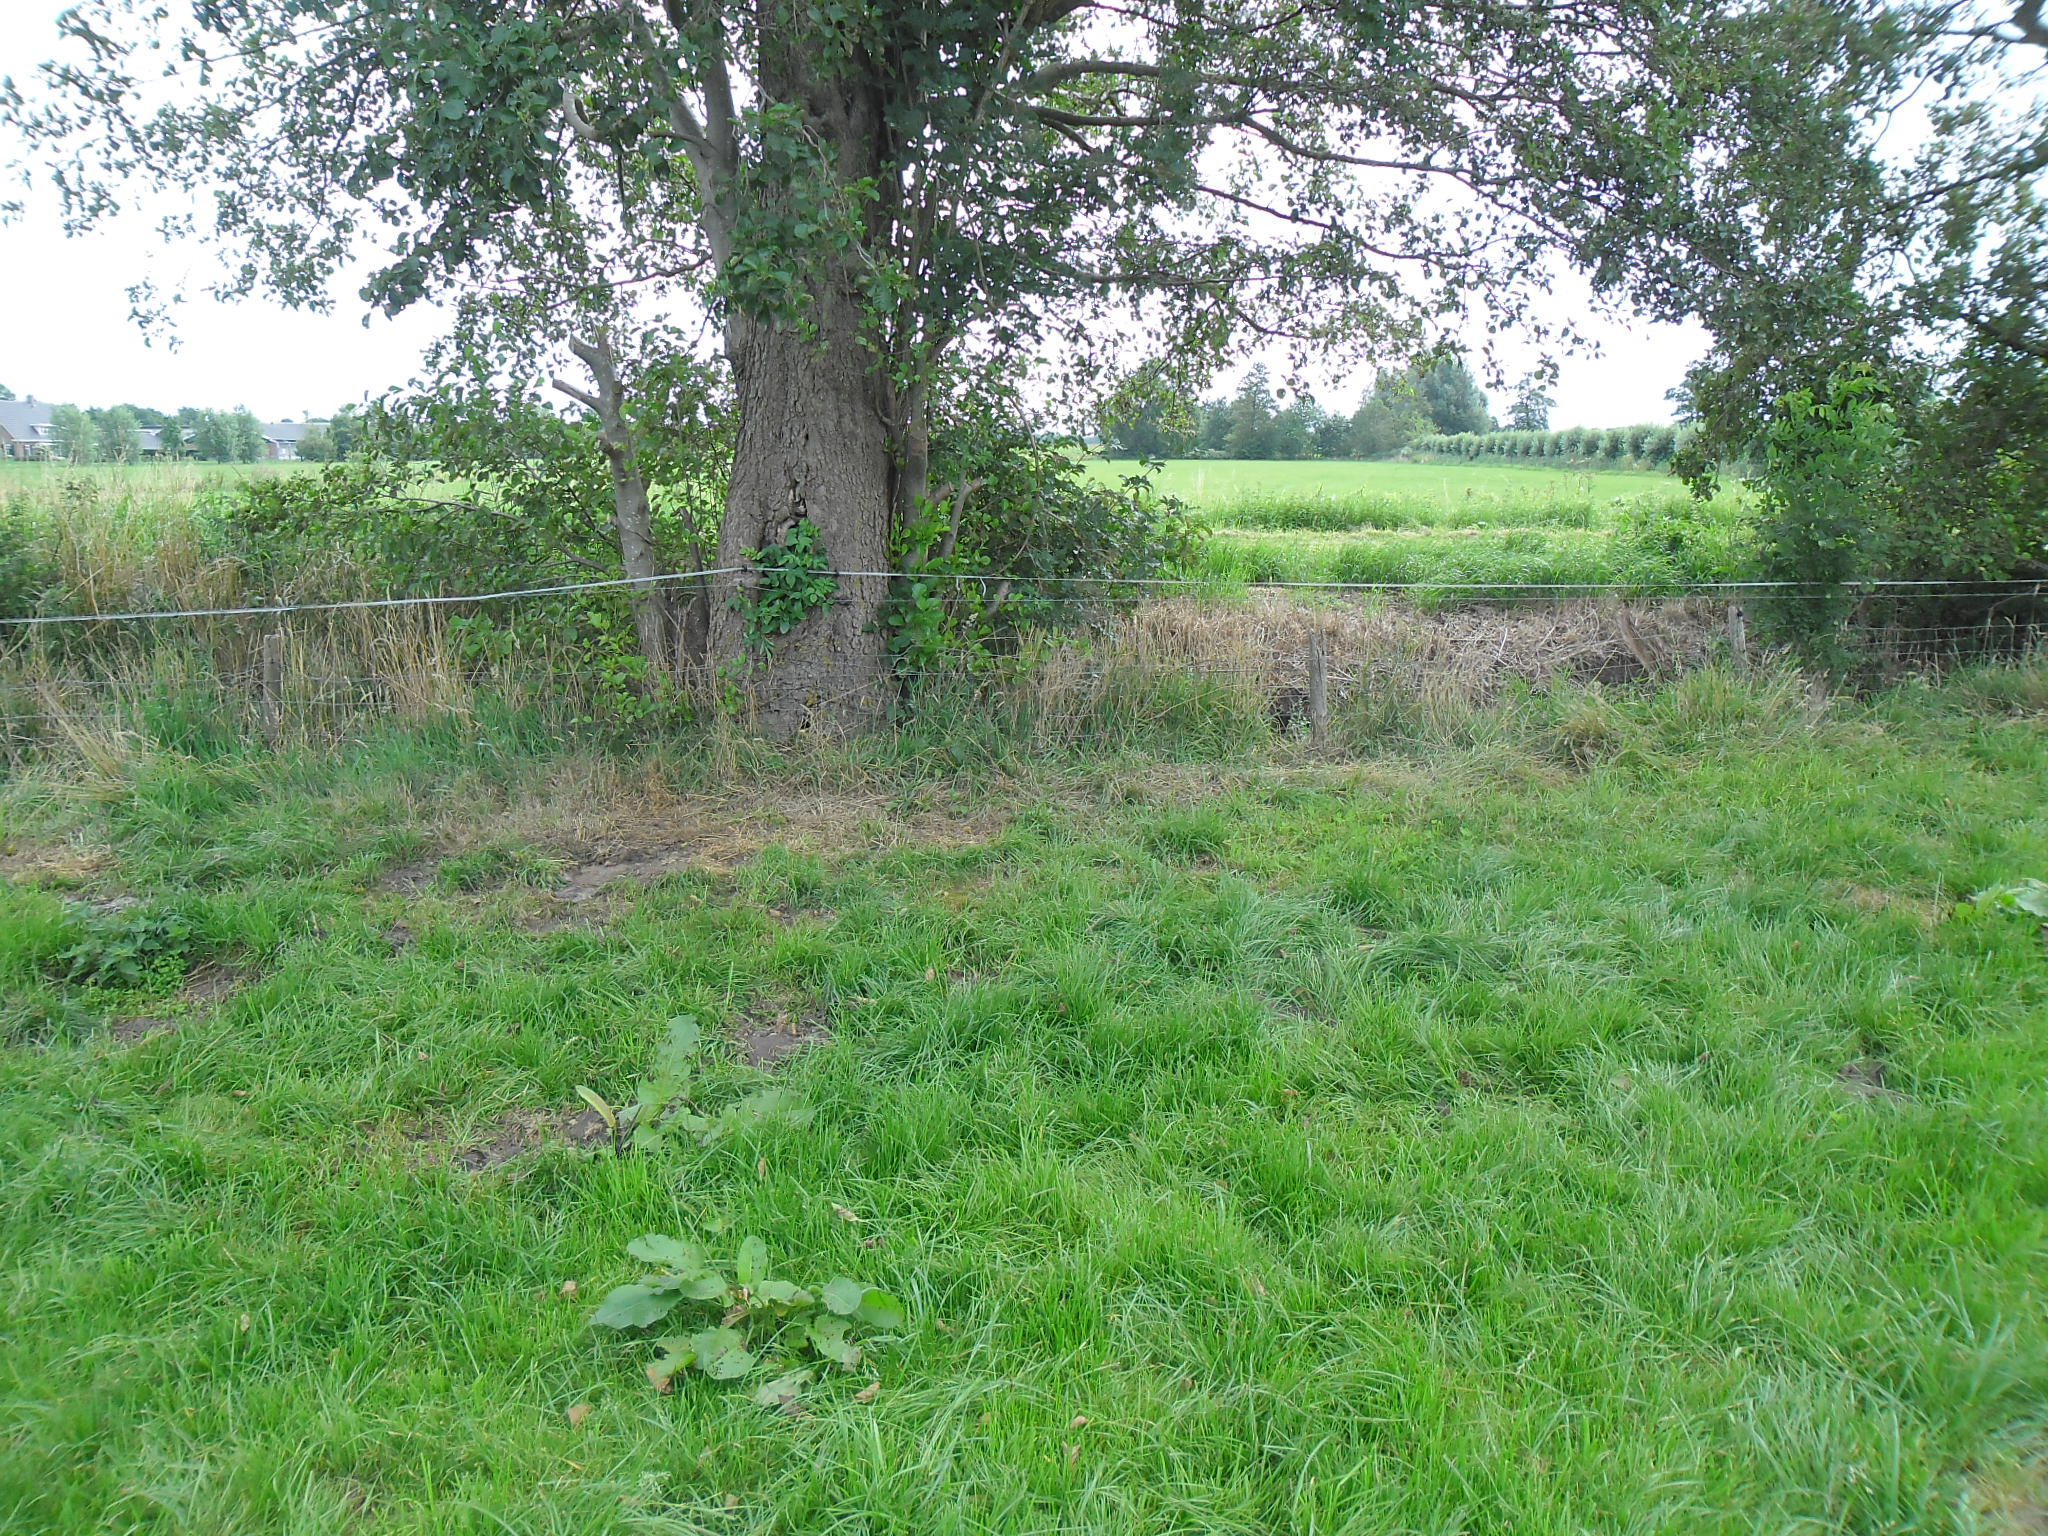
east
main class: Grassland
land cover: Grassland without tree/shrub cover
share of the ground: > 75 %
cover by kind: herbaceous plants 100 %
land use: Agriculture (excluding fallow land and kitchen gardens)
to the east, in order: Grassland without tree/shrub cover; Fences; Single bushes/trees; Ditches and canals; Grass margins; Paved roads, cycling and walking lanes; Grassland without tree/shrub cover; Ditches and canals; Fences; Grassland without tree/shrub cover; Fences; Grass margins; Ditches and canals; Grass margins; Fences; Grassland without tree/shrub cover
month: August
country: NL
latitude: 52.4442
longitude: 6.2479
